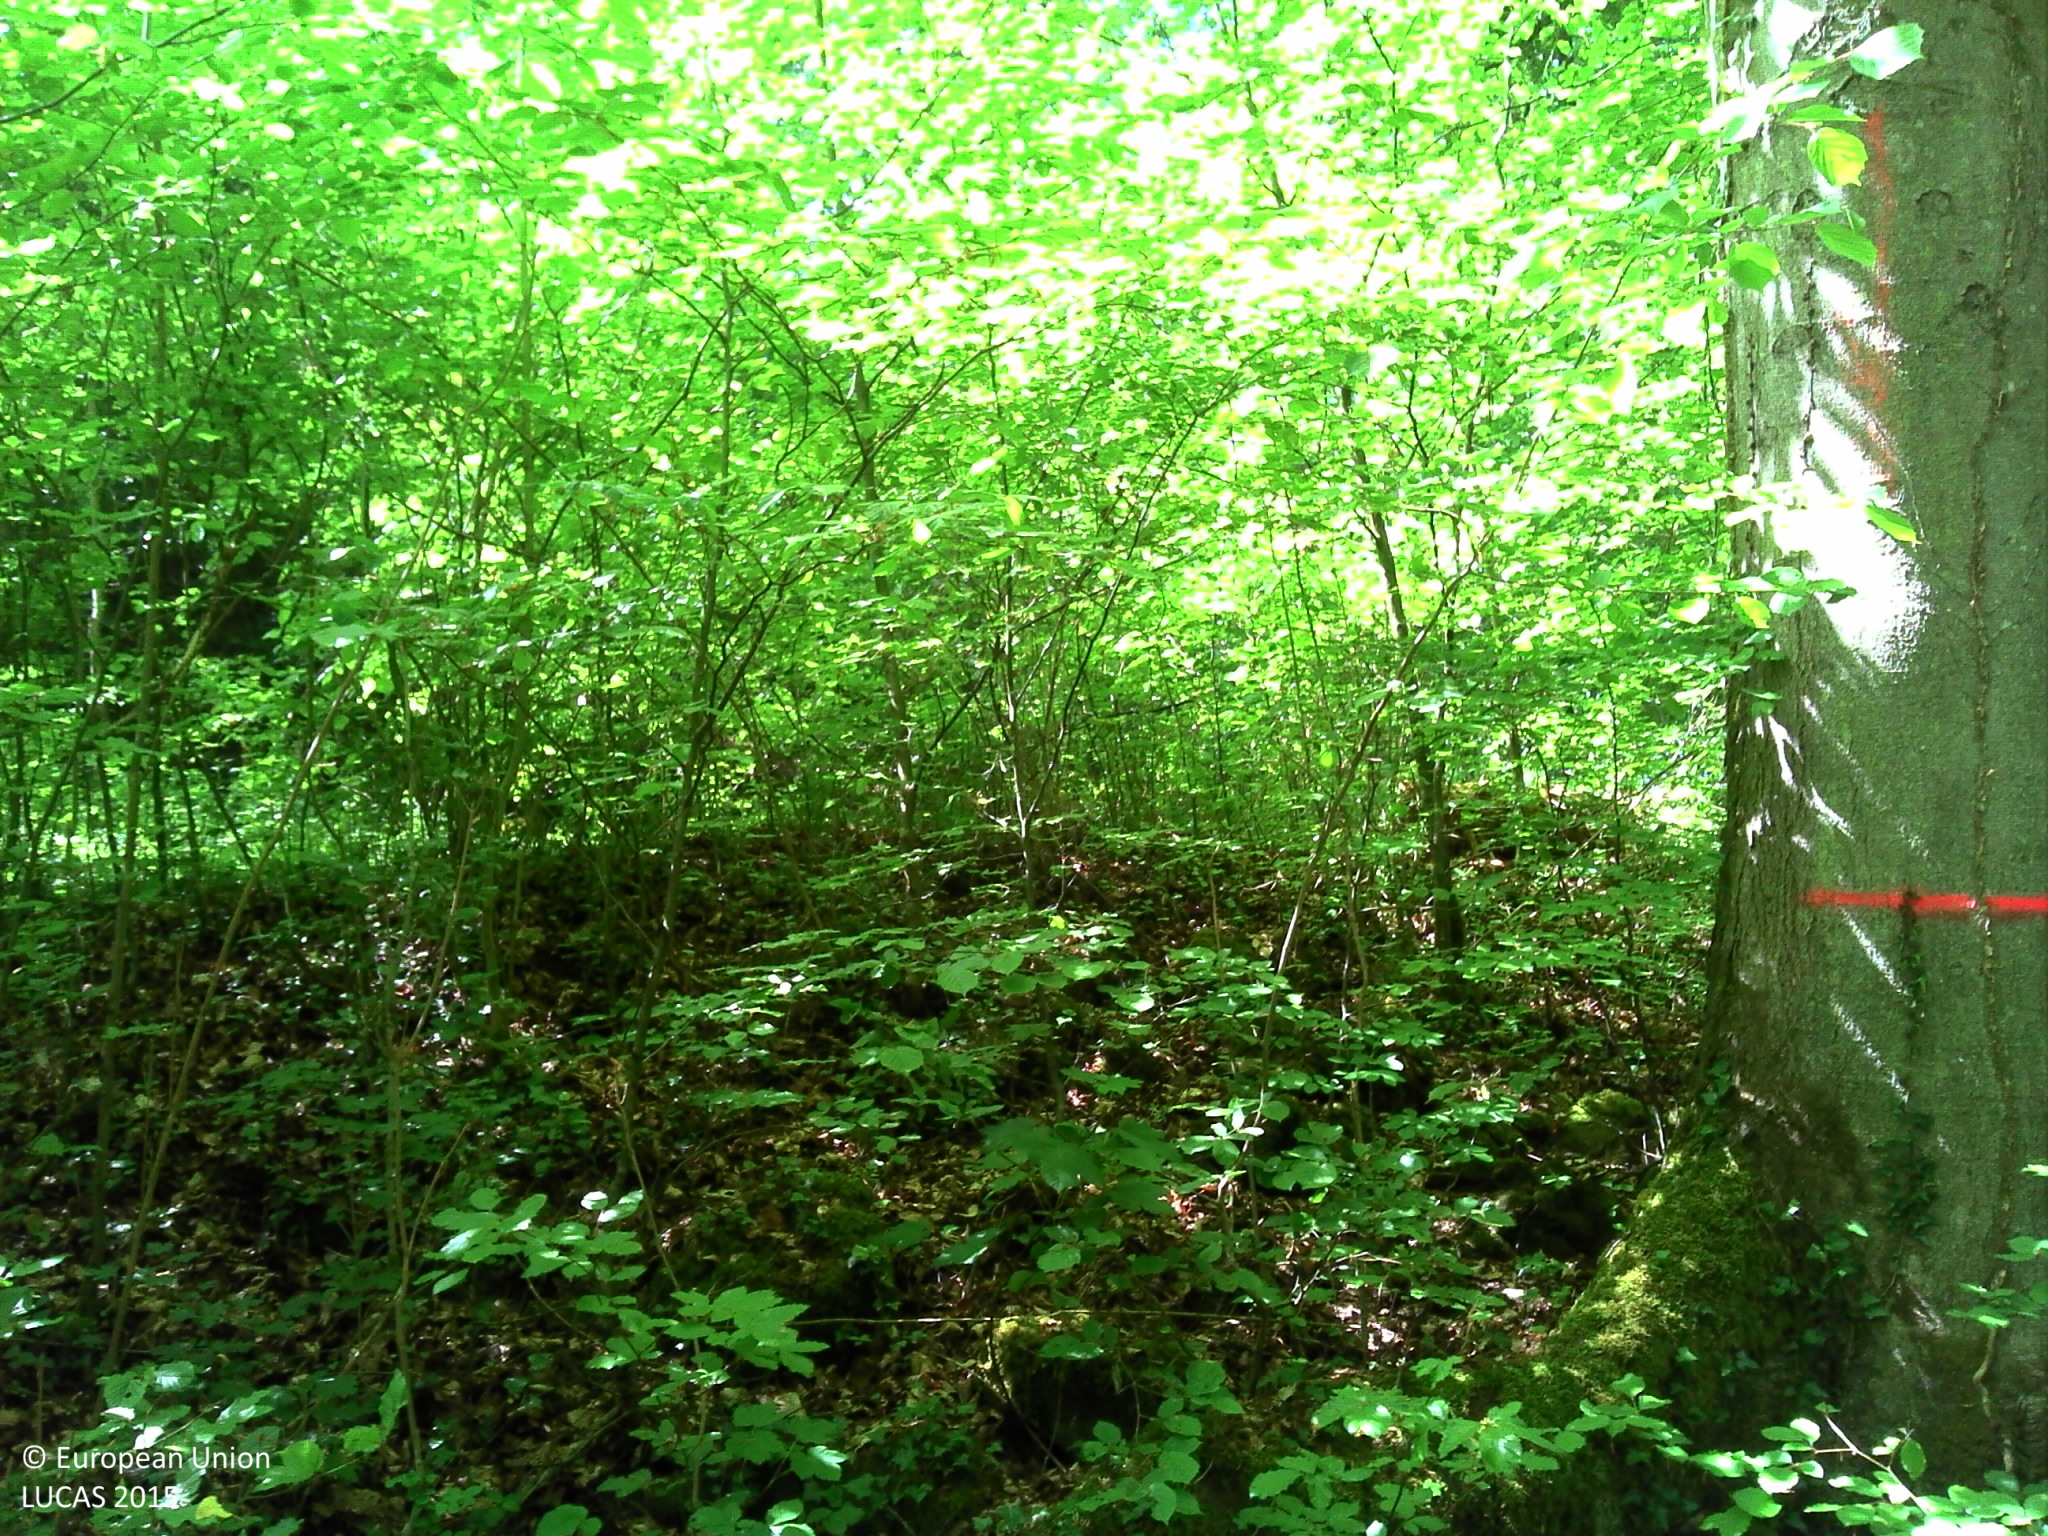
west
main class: Woodland
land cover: Broadleaved woodland
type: acidophilous oak and oak-birch forest
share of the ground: > 75 %
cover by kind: broadleaved forest trees 95 %, herbaceous plants 5 %
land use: Forestry
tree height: > 5 m
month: May
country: LU
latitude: 49.7334
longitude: 6.4618
